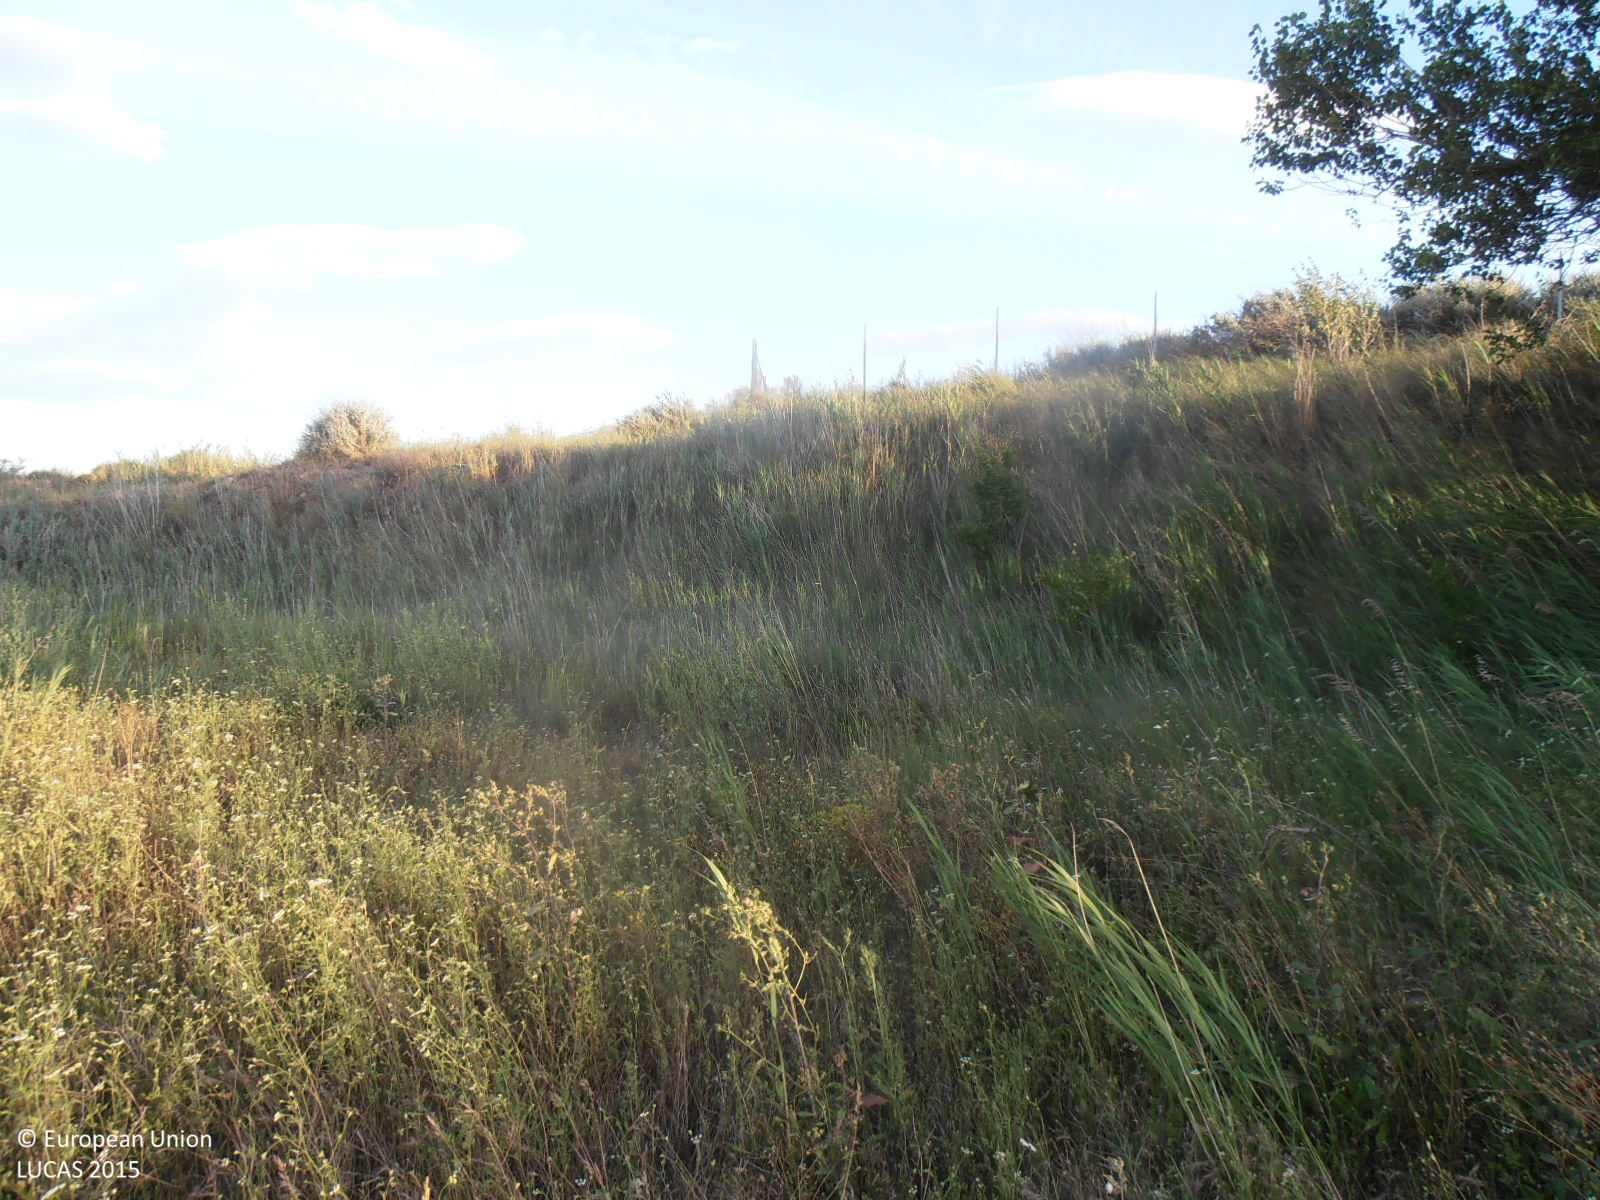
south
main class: Grassland
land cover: Grassland without tree/shrub cover
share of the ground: > 75 %
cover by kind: herbaceous plants 100 %
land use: Abandoned areas
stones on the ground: < 10 %
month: June
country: ES
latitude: 41.9460
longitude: -1.3065
